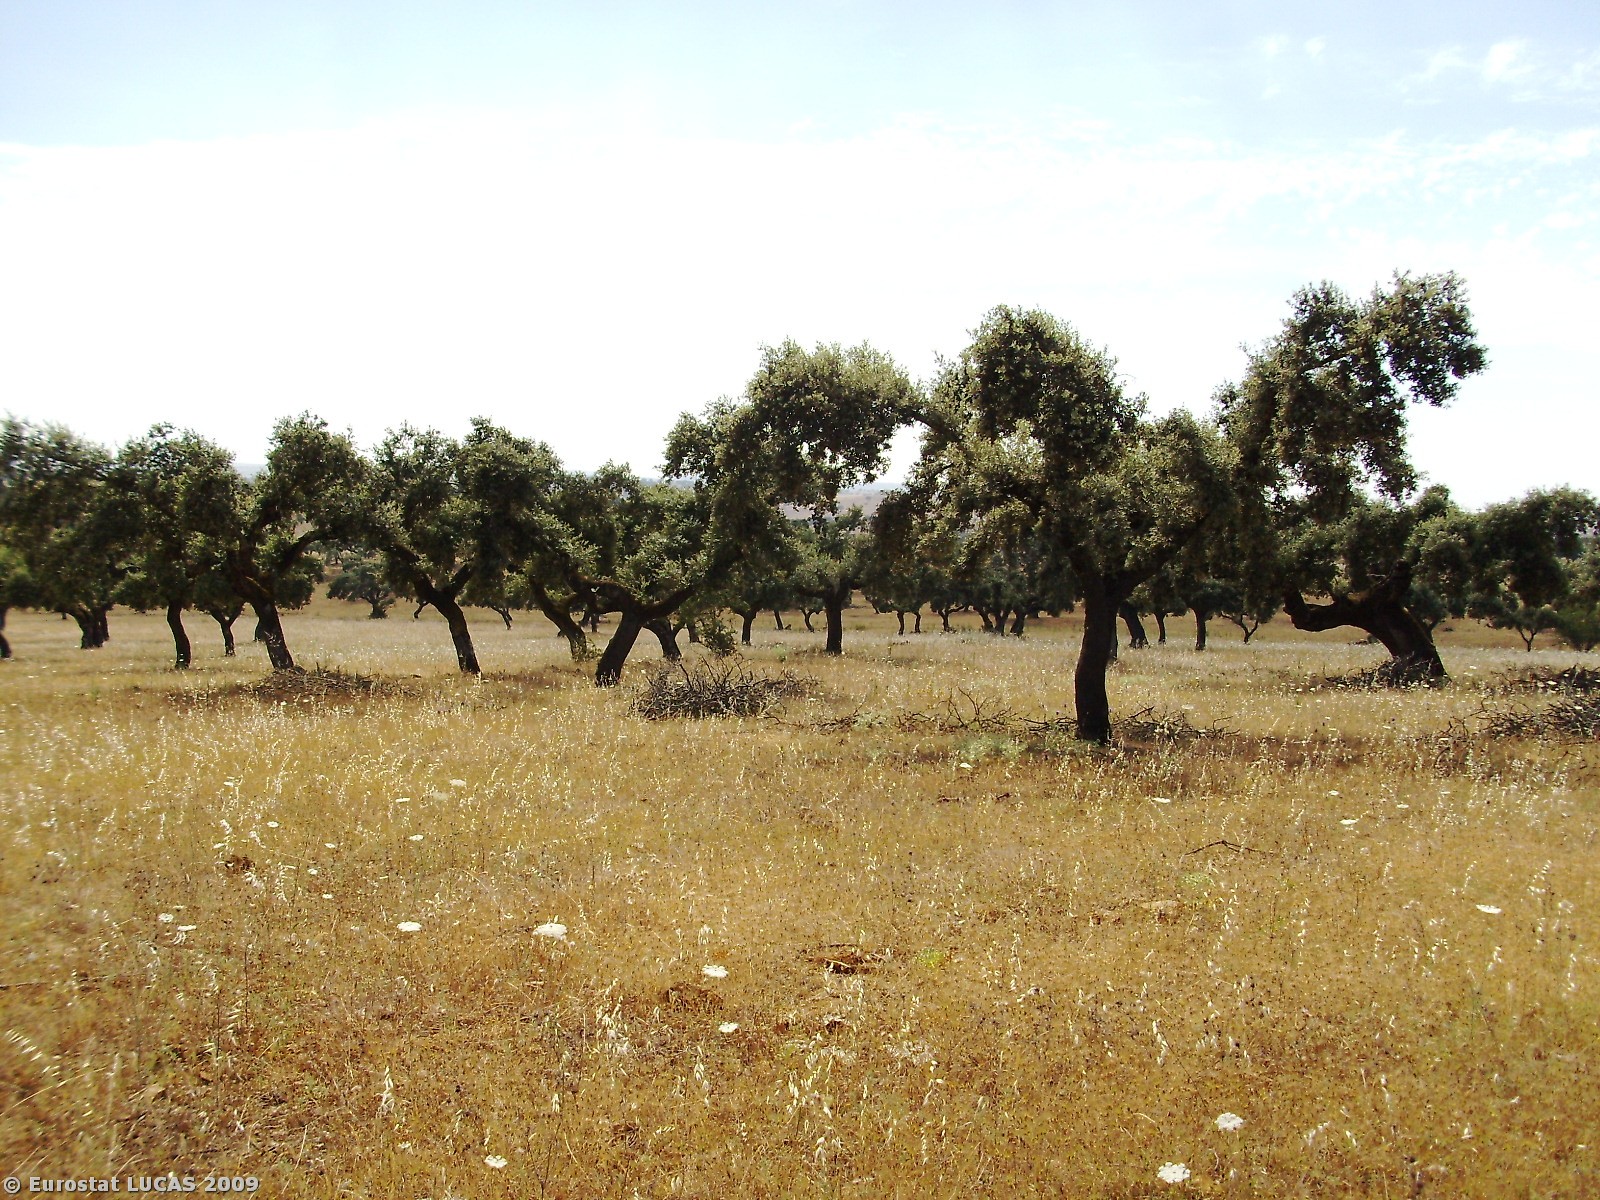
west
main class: Woodland
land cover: Broadleaved woodland
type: broadleaved evergreen forest
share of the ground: 10 - 25 %
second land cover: Spontaneously vegetated surfaces
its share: 50 - 75 %
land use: Forestry
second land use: Fallow land
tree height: > 5 m
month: June
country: PT
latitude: 39.1101
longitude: -7.3722
